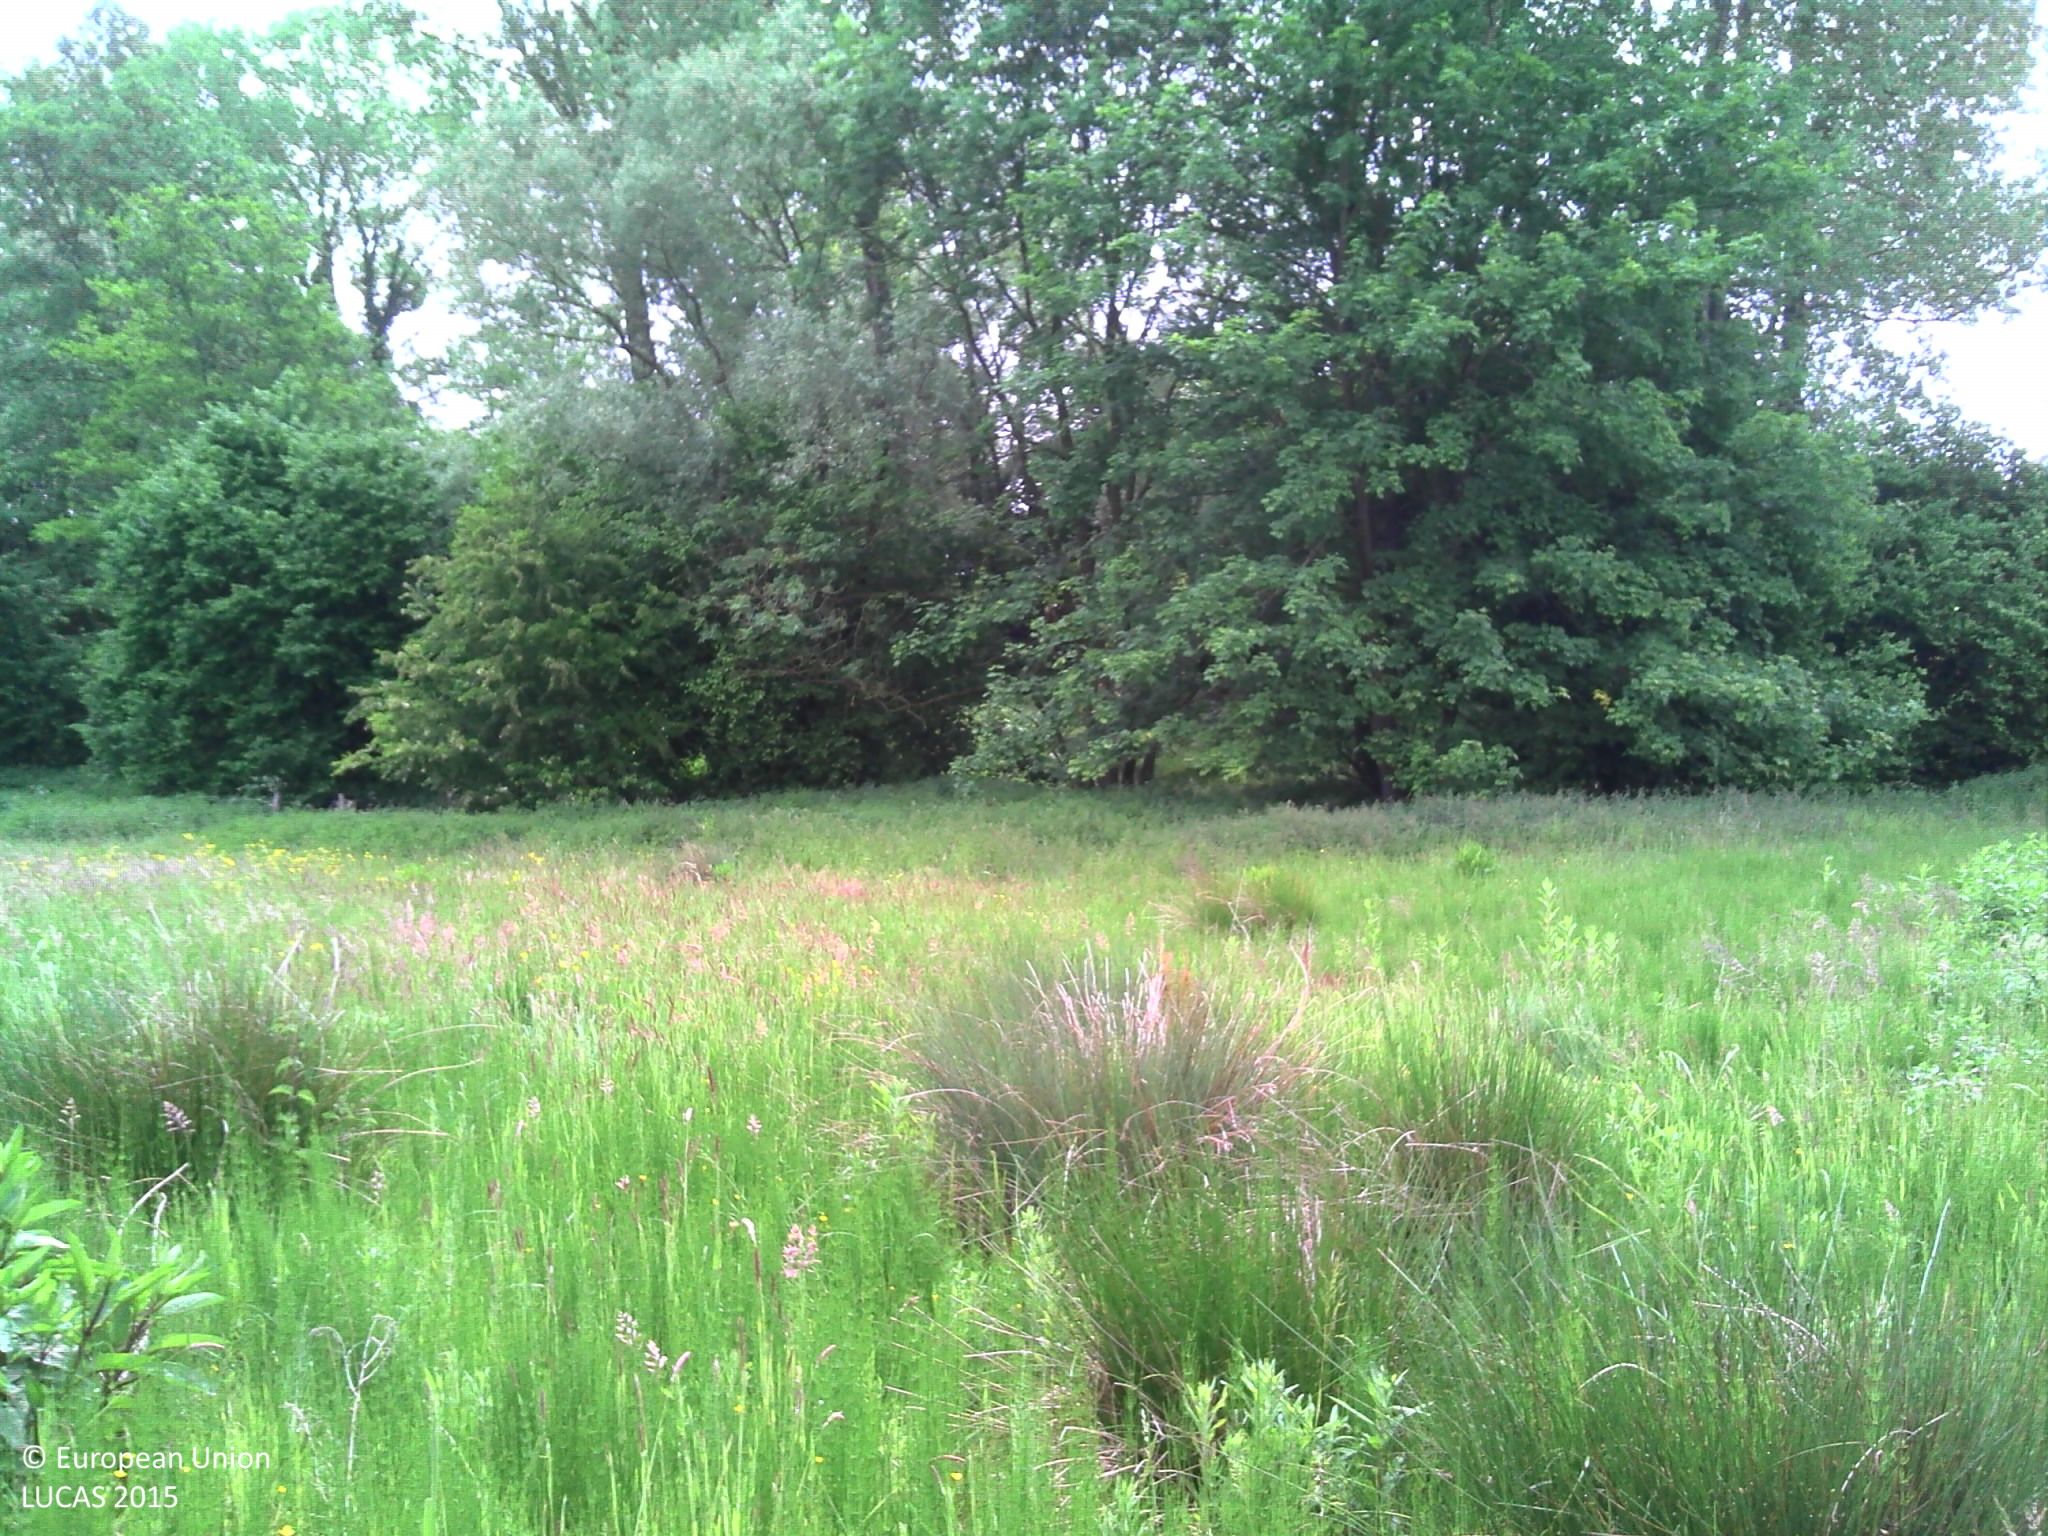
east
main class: Grassland
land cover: Grassland without tree/shrub cover
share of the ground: > 75 %
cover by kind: herbaceous plants 100 %
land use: Agriculture (excluding fallow land and kitchen gardens)
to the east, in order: Grassland without tree/shrub cover; Broadleaved woodland; Inland fresh running water; Broadleaved woodland; Grassland without tree/shrub cover; Fences; Broadleaved woodland; Fences; Grassland without tree/shrub cover; Fences; Sugar beet
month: June
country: BE
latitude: 50.8041
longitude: 4.0488
